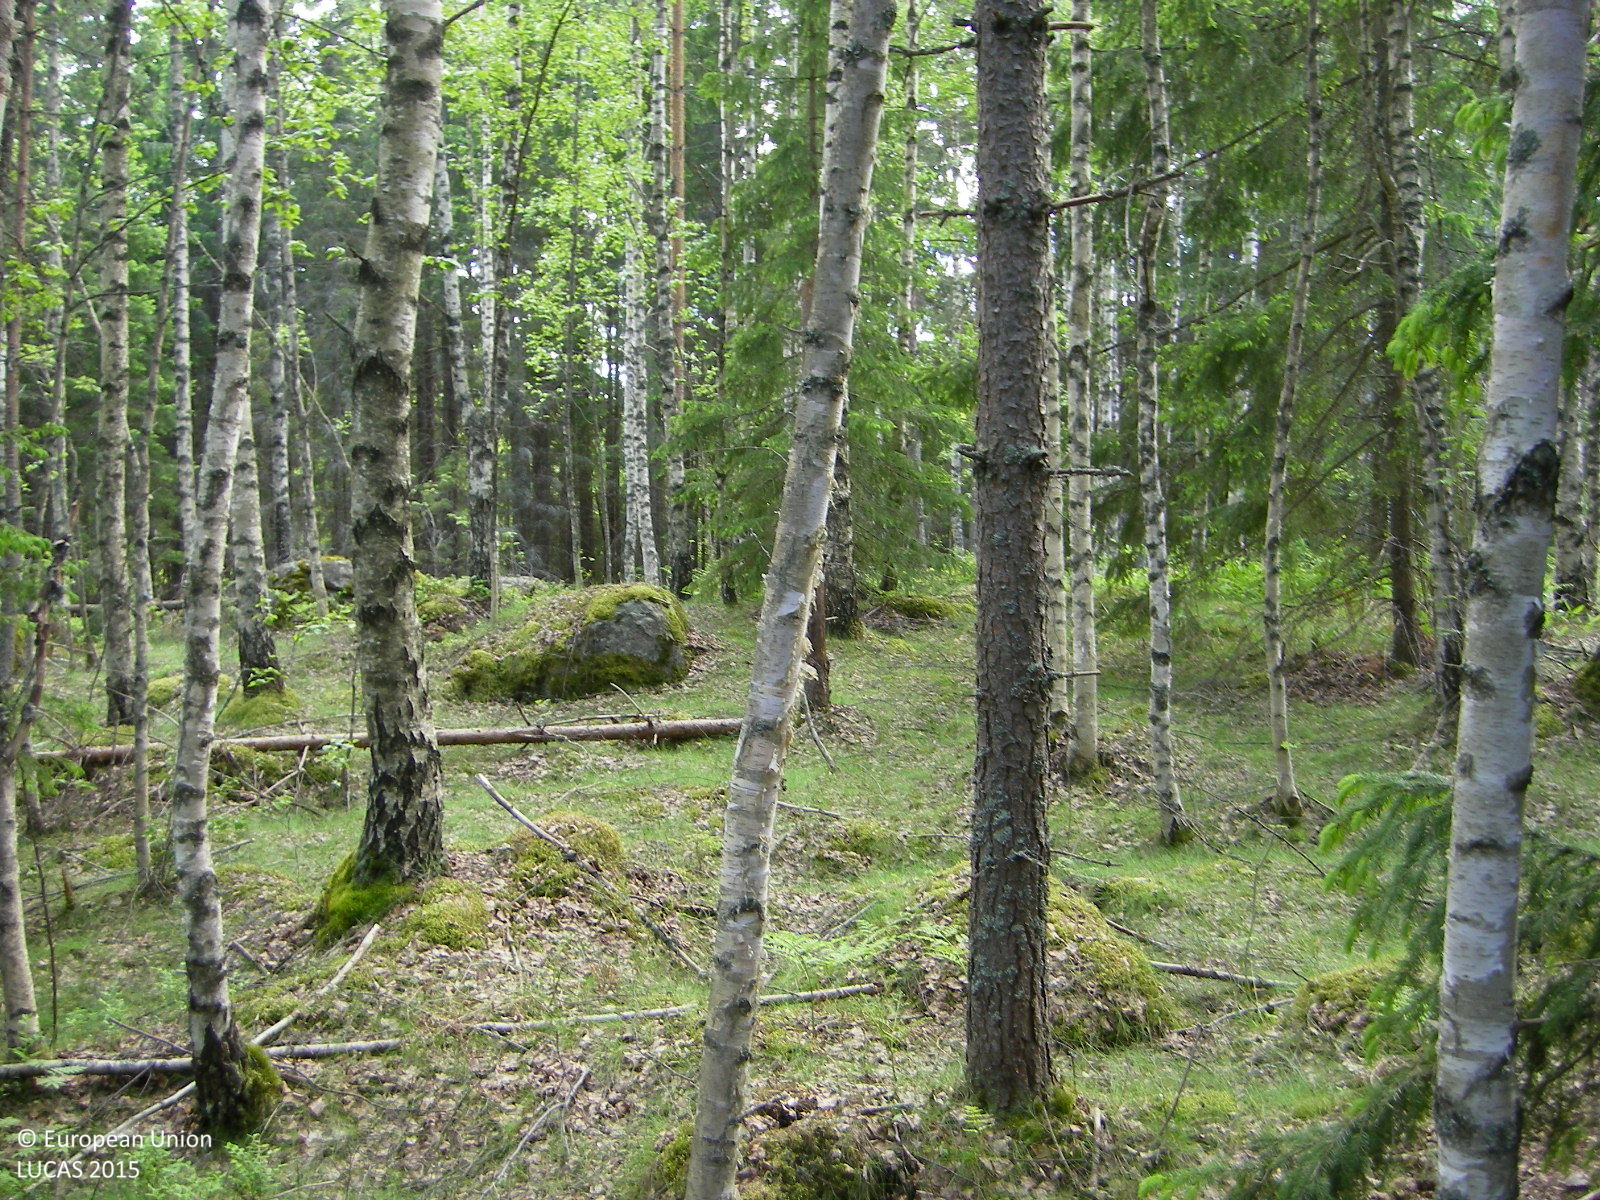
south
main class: Woodland
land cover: Spruce dominated mixed woodland
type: boreal forest
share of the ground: > 75 %
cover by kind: broadleaved forest trees 60 %, coniferous forest trees 30 %, herbaceous plants 5 %, lichens and mosses 5 %
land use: Forestry
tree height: > 5 m
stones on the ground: < 10 %
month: June
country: FI
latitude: 60.1907
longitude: 24.5550
